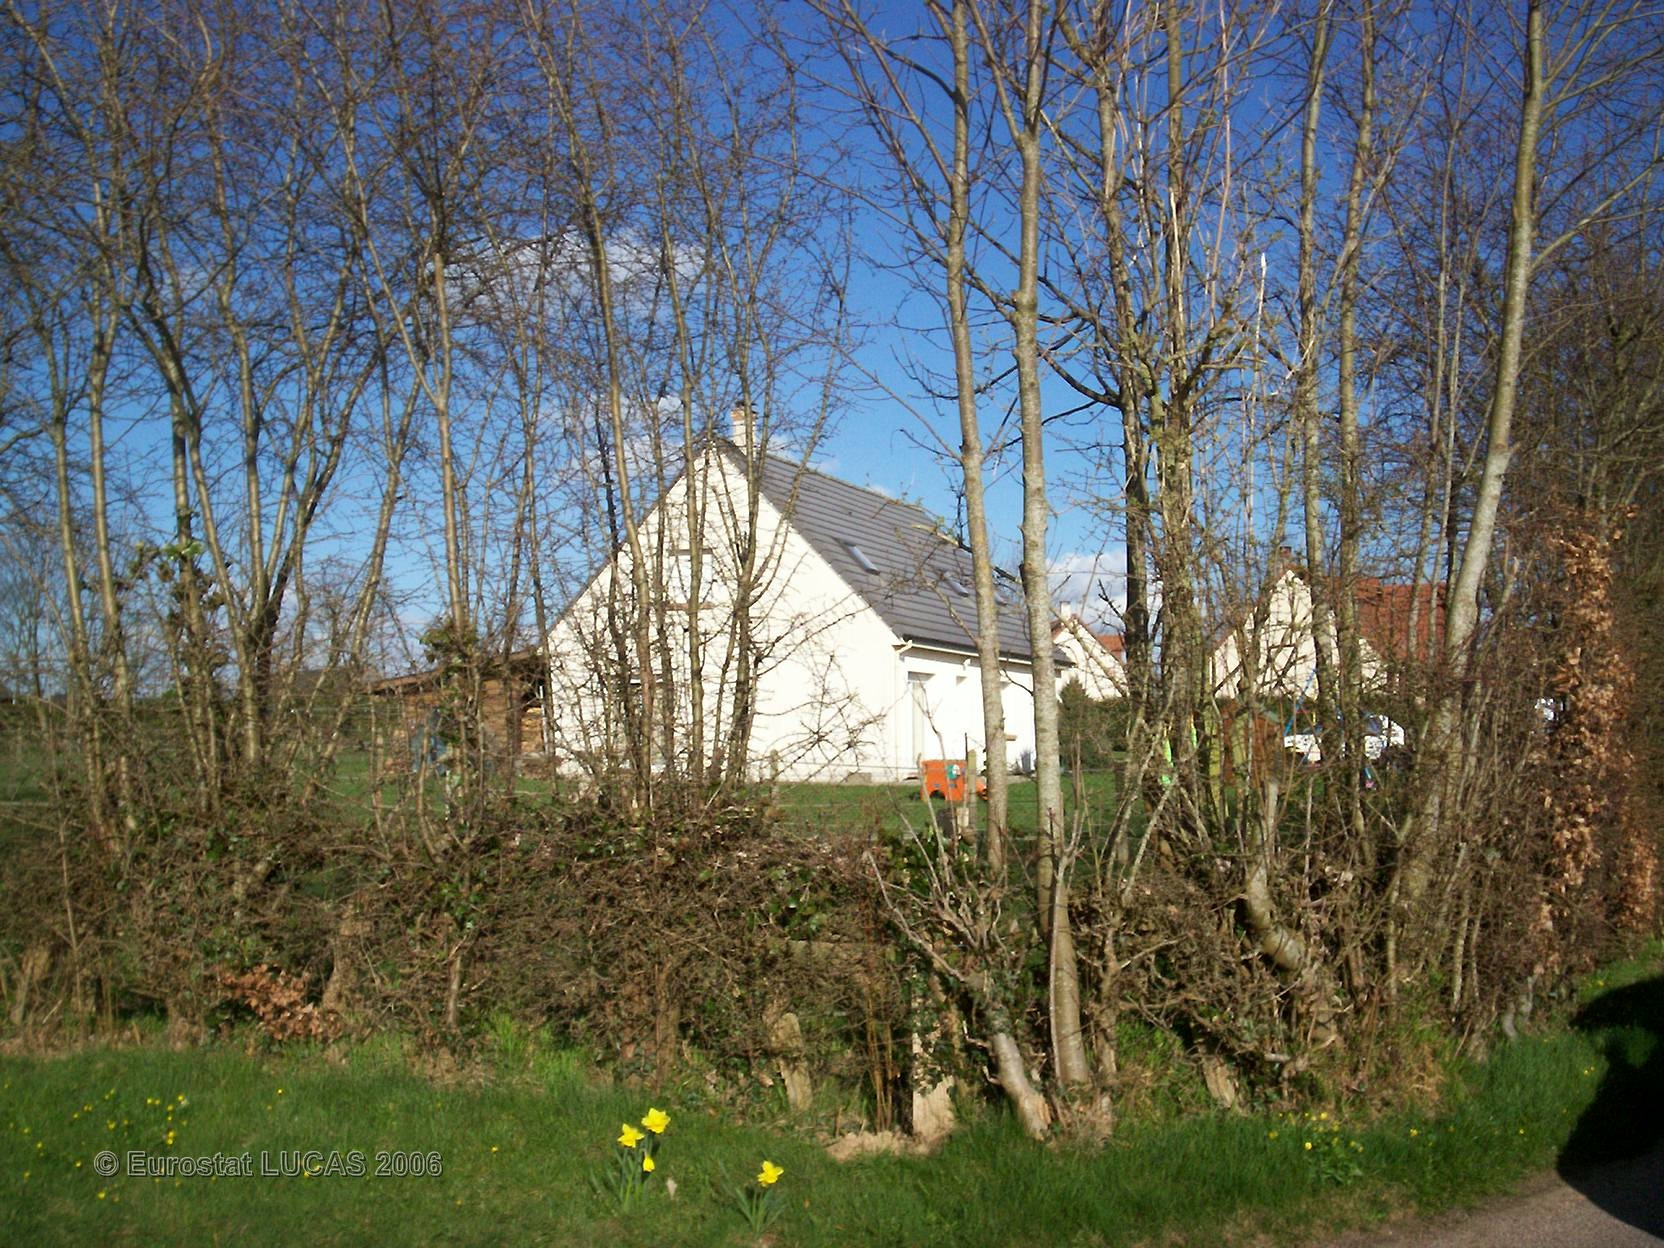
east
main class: Cropland
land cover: Common wheat
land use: Agriculture (excluding fallow land and kitchen gardens)
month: June
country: FR
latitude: 49.6236
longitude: 0.9375
